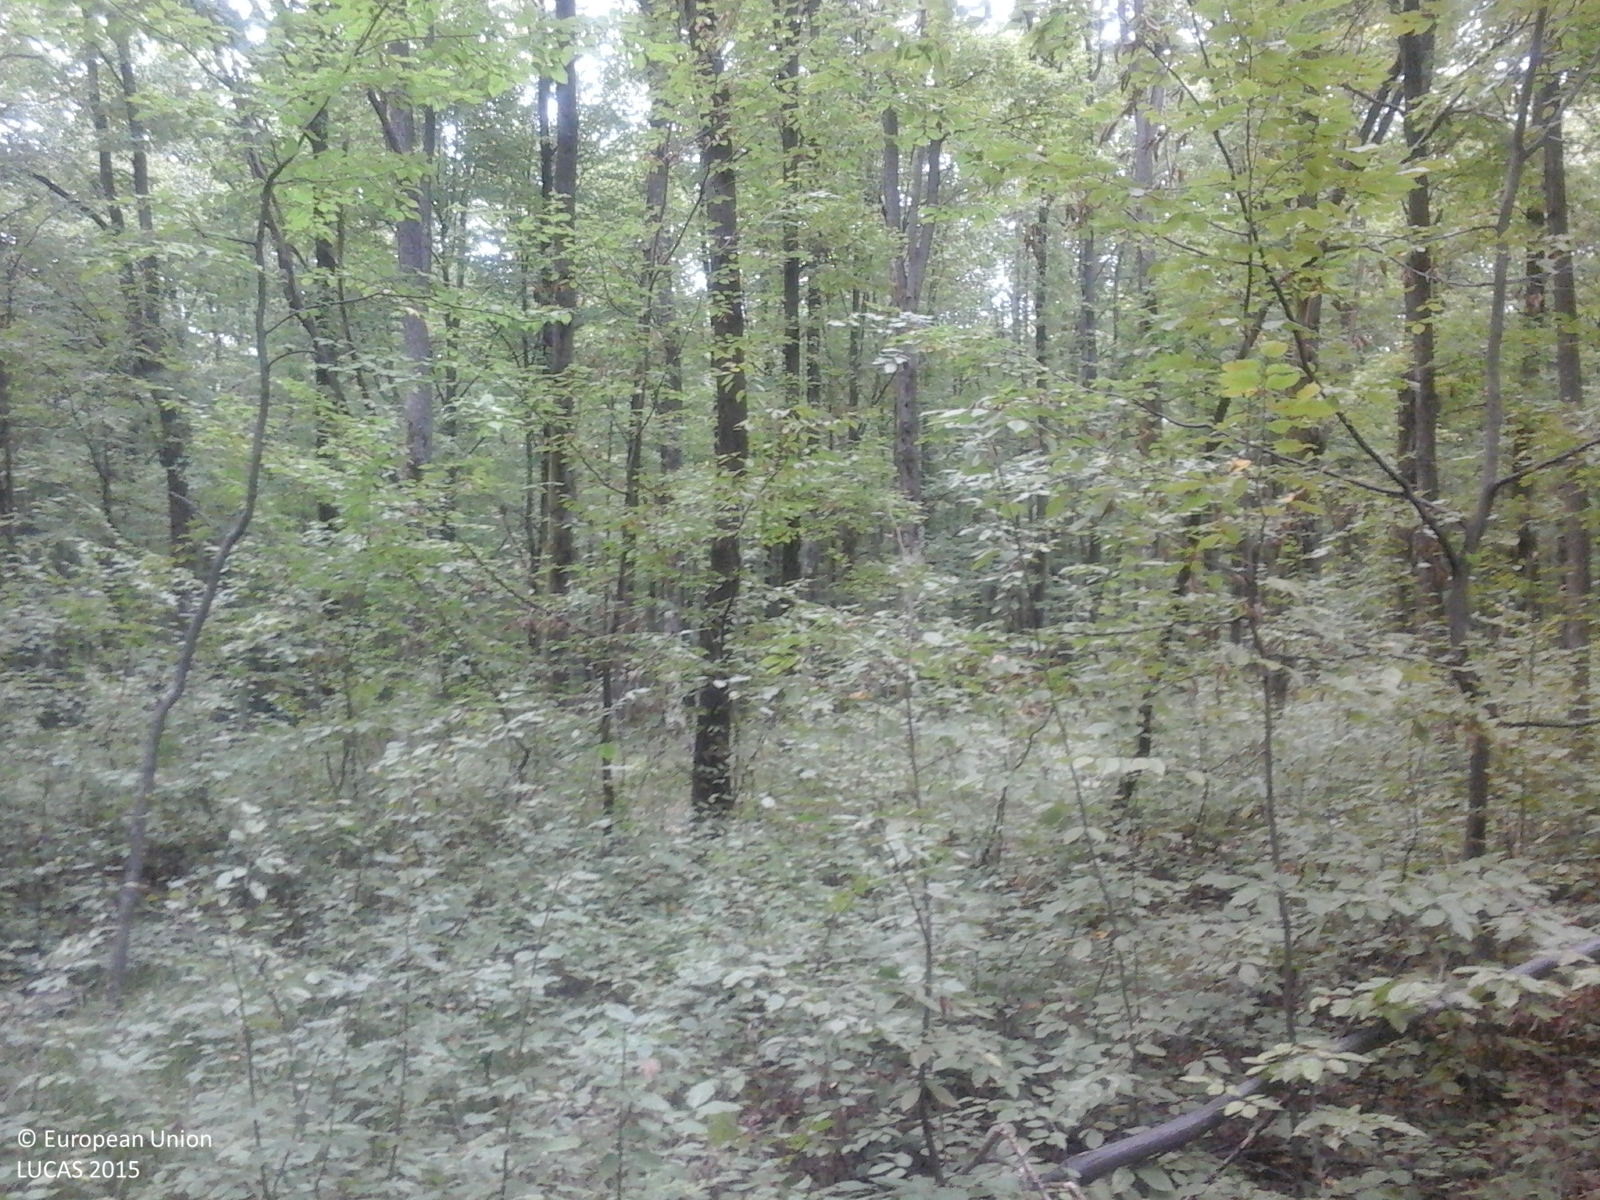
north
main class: Woodland
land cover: Broadleaved woodland
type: acidophilous oak and oak-birch forest
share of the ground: > 75 %
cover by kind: broadleaved forest trees 100 %
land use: Forestry
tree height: > 5 m
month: September
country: RO
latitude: 44.9475
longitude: 23.3240
